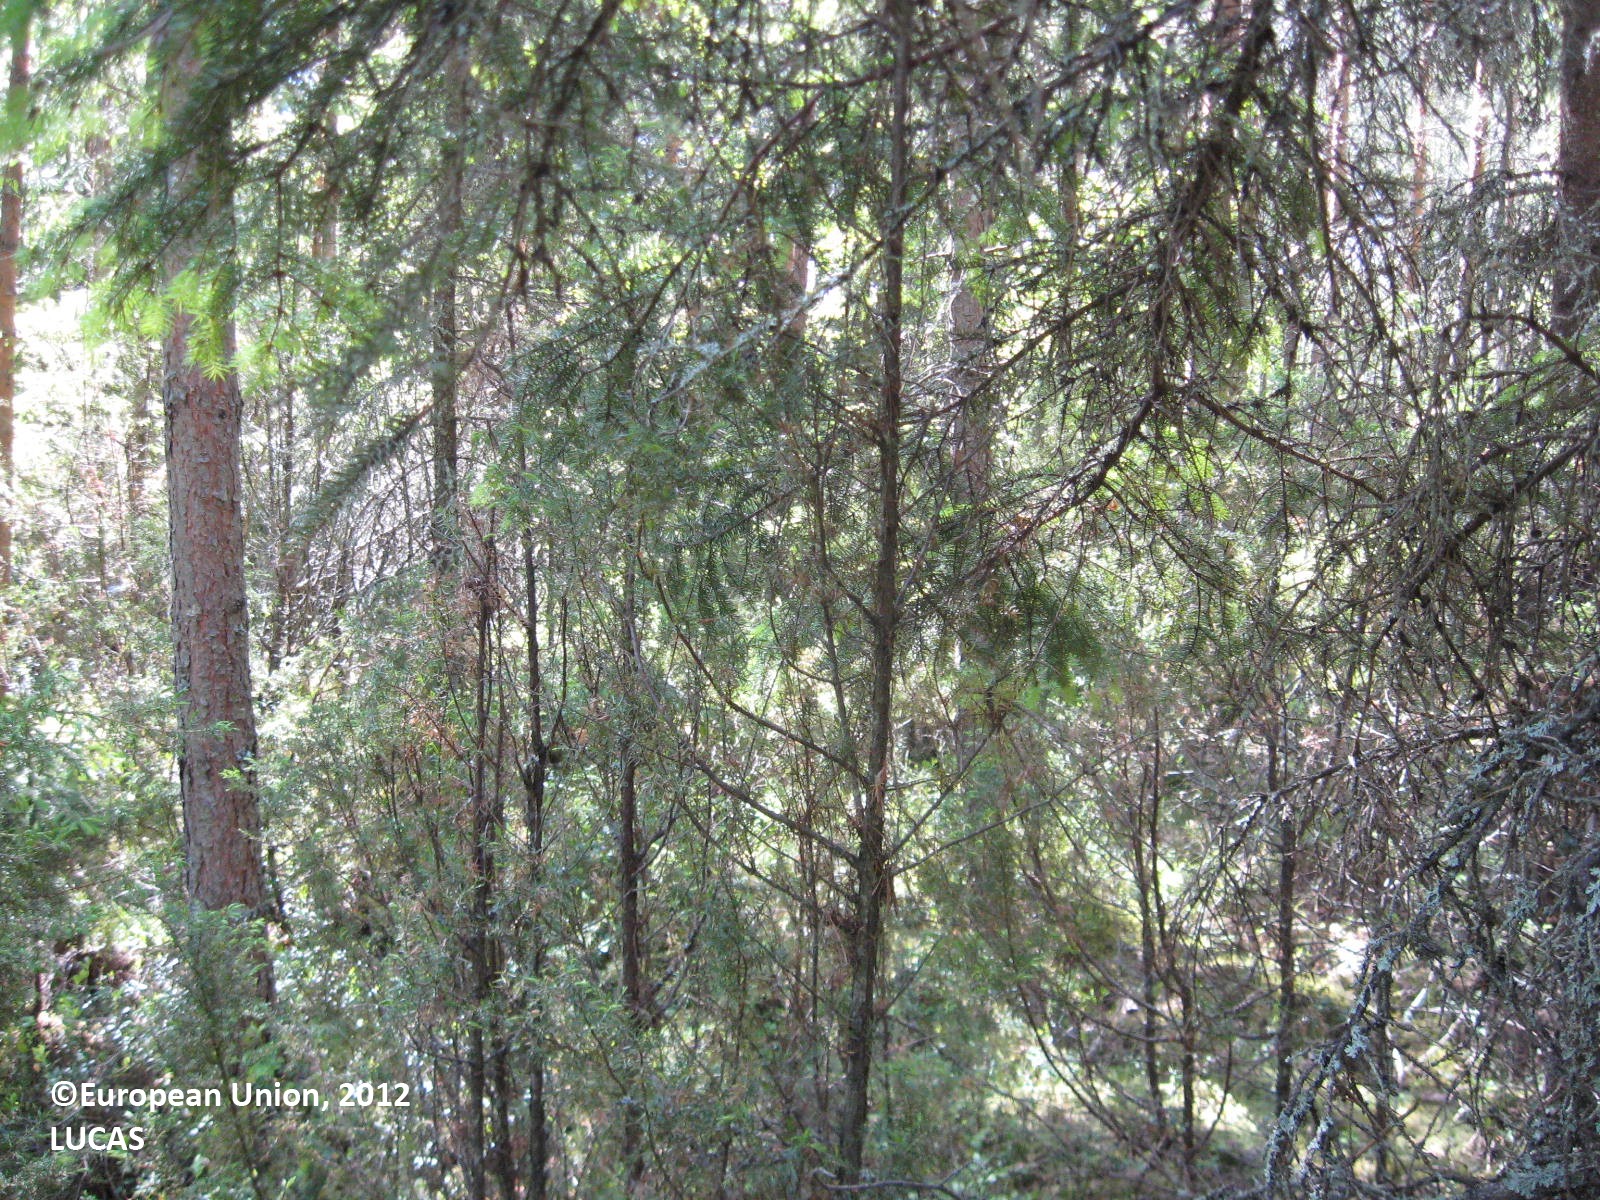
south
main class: Woodland
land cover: Spruce dominated coniferous woodland
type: boreal forest
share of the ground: > 75 %
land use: Forestry
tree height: > 5 m
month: June
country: FI
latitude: 62.7106
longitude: 21.5971
